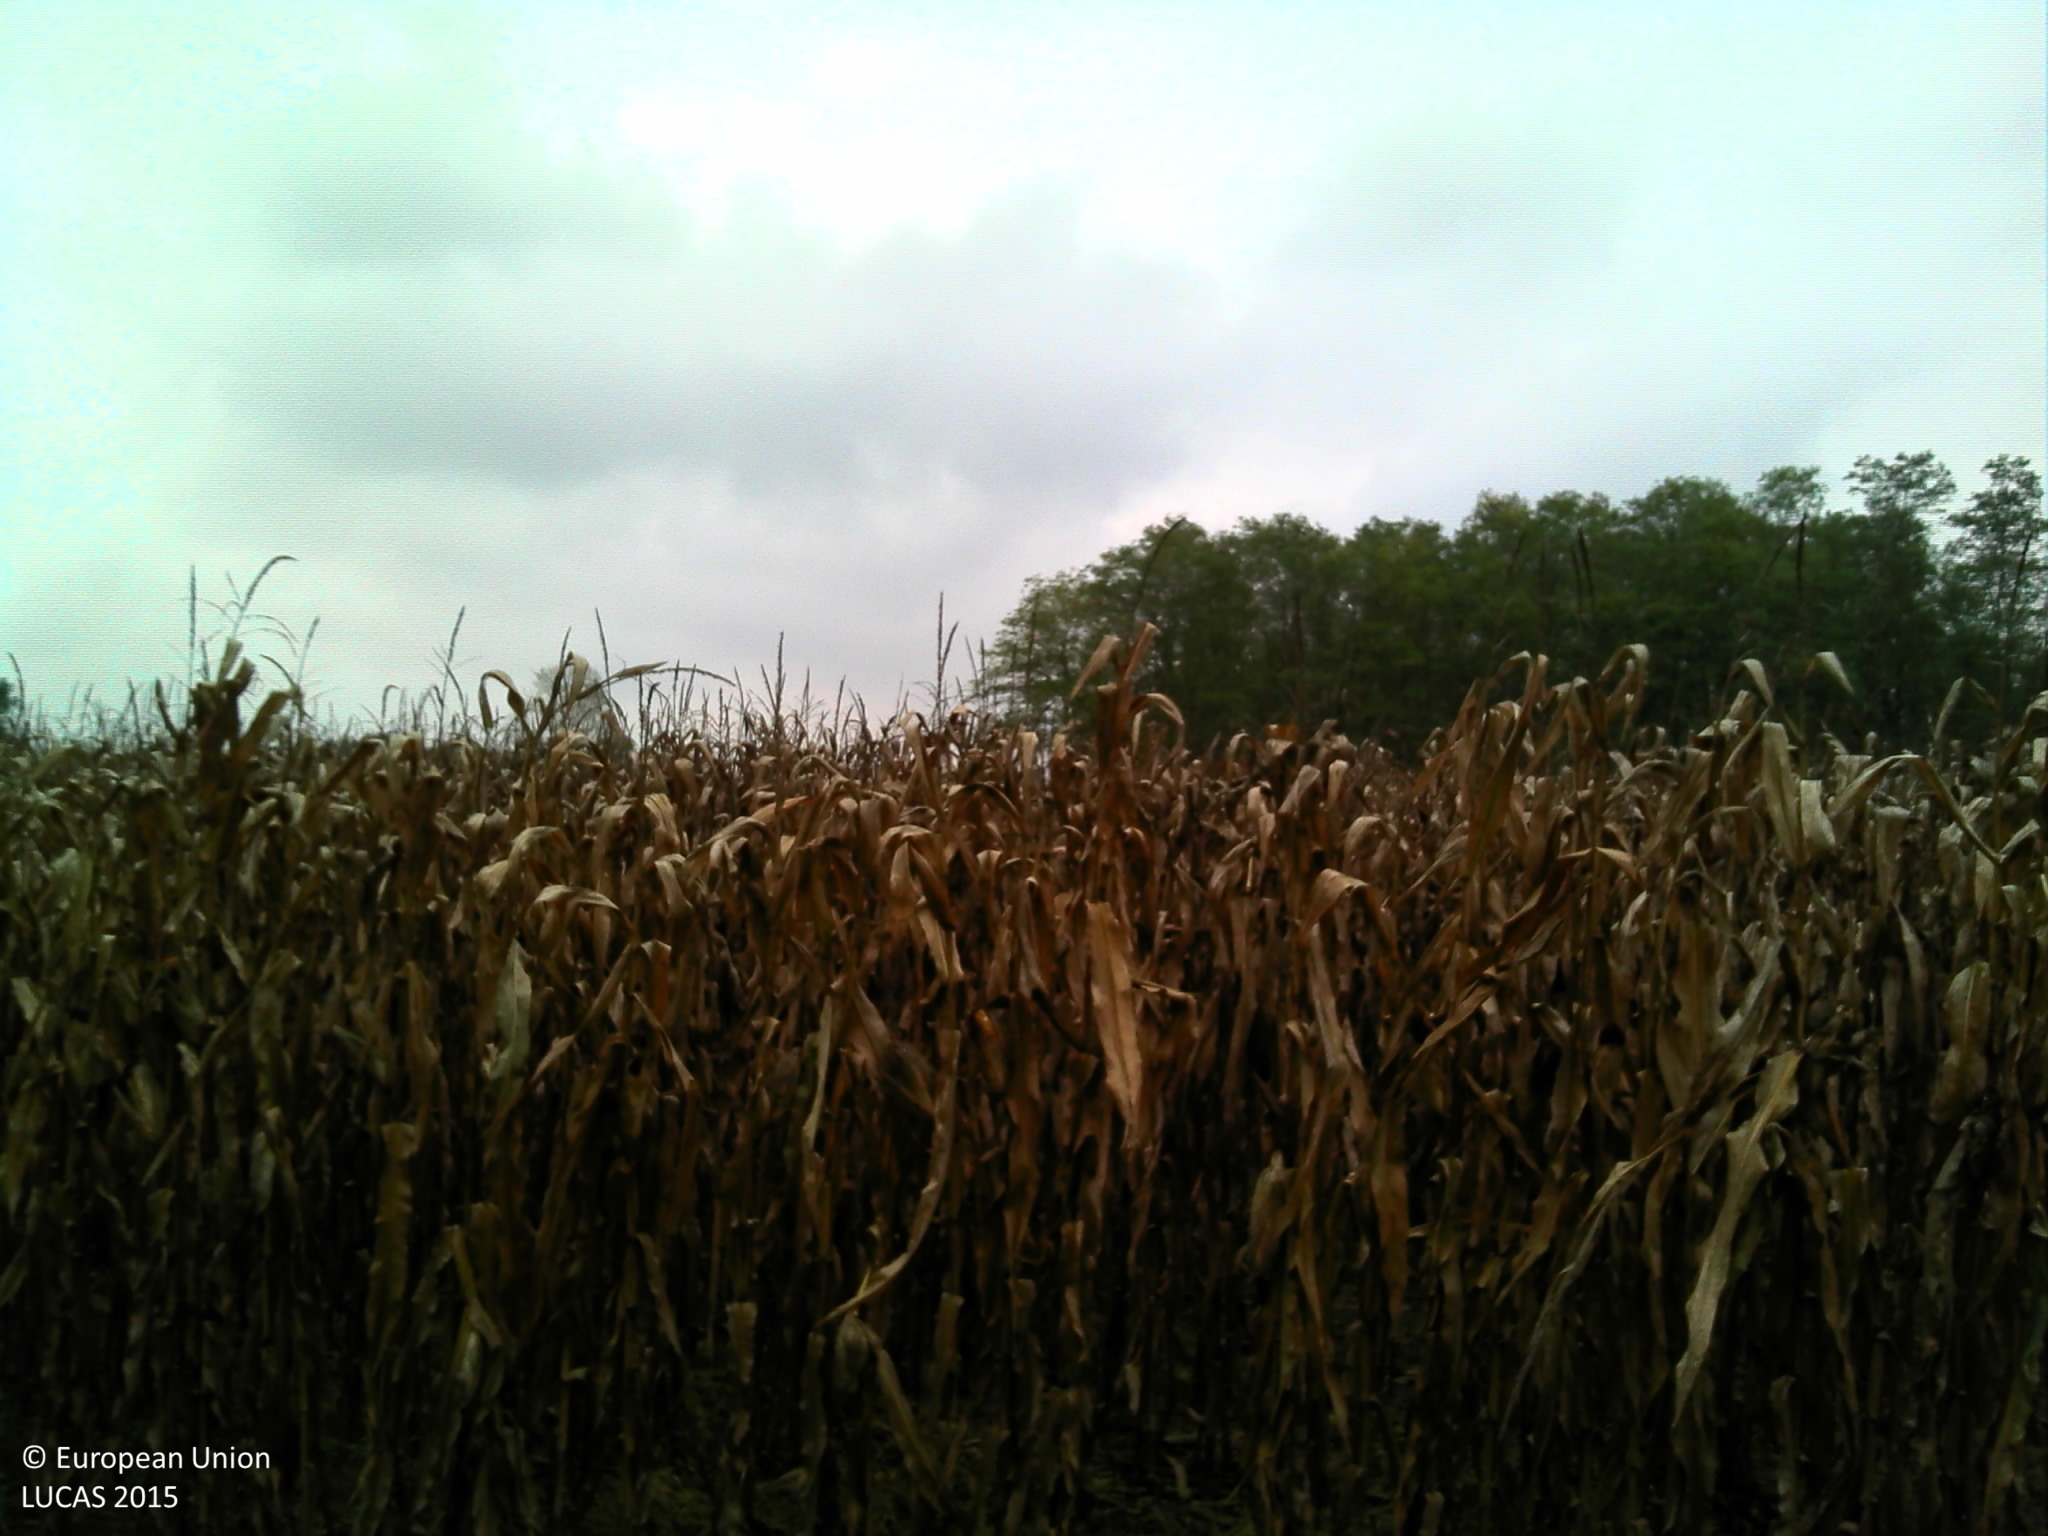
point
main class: Cropland
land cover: Maize
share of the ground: > 75 %
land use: Agriculture (excluding fallow land and kitchen gardens)
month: October
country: FR
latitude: 46.2262
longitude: 4.8293
